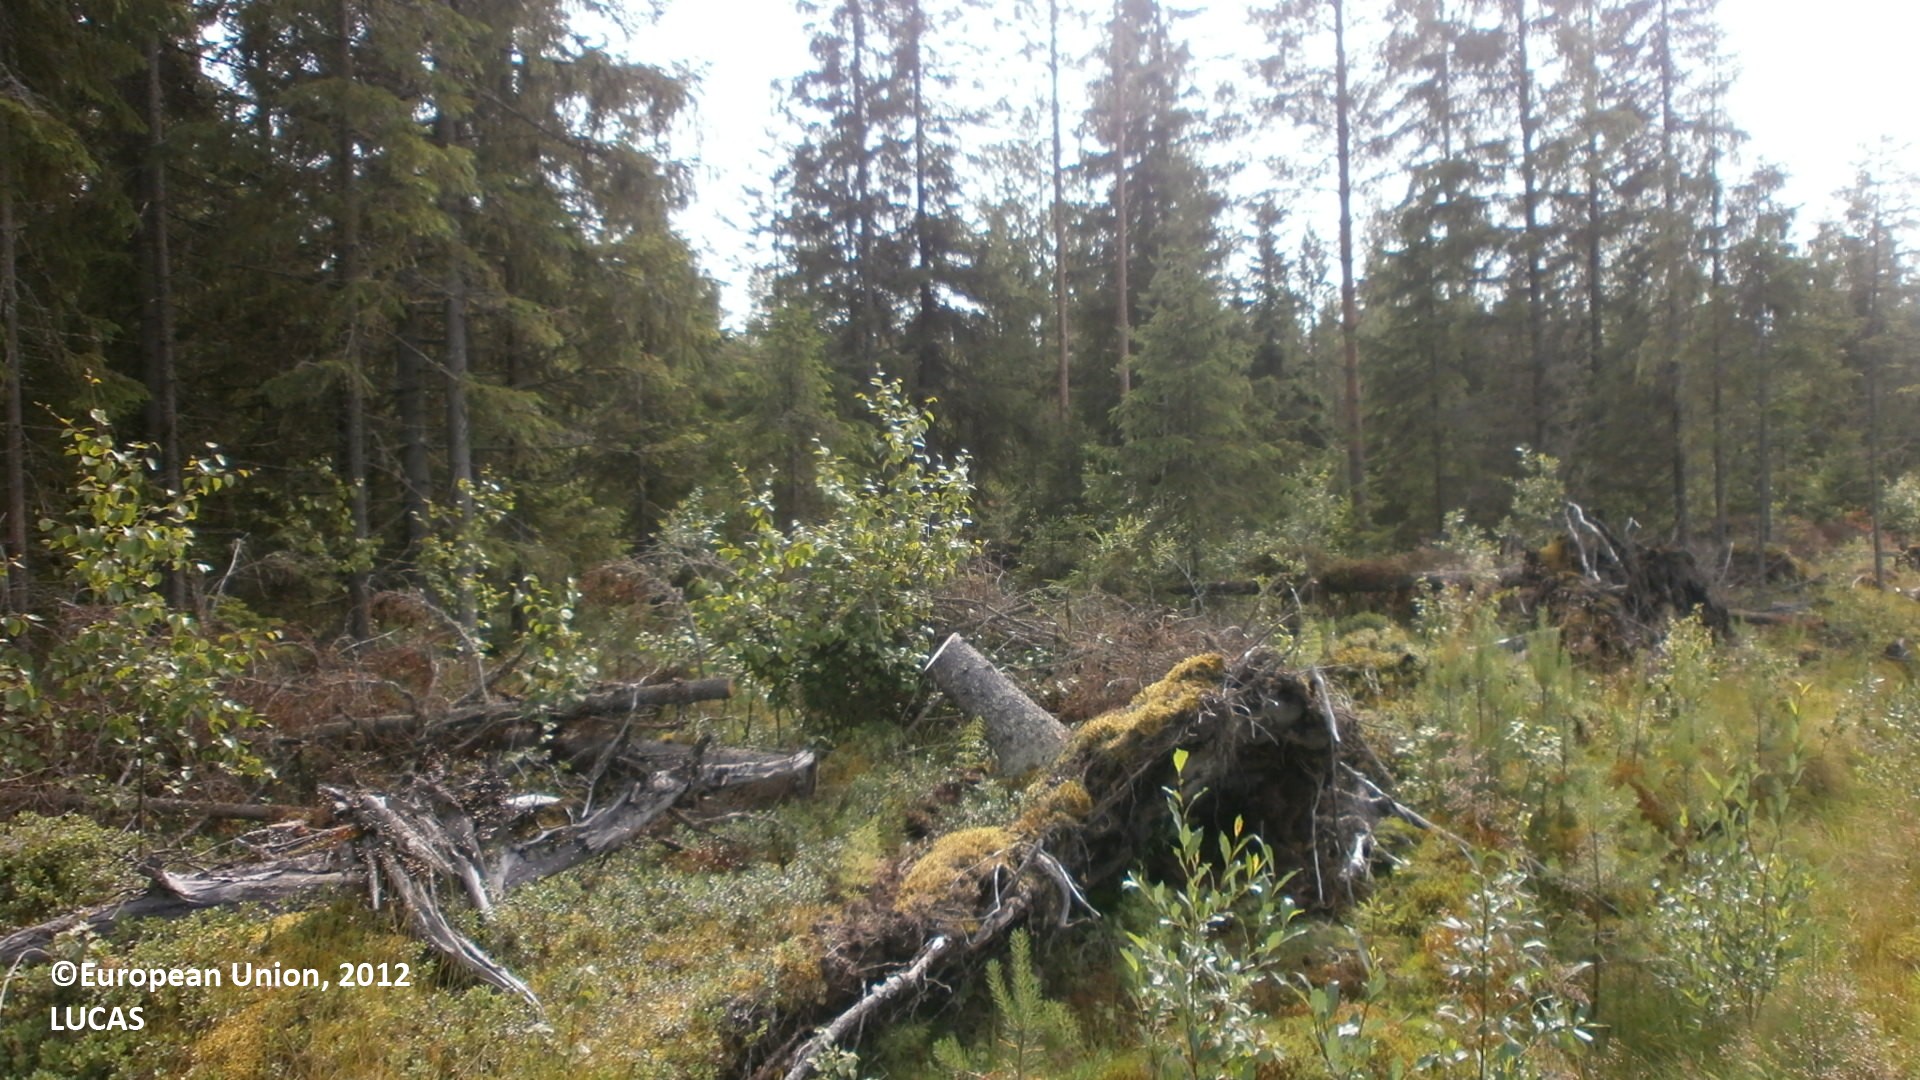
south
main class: Cropland
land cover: Barley
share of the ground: > 75 %
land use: Agriculture (excluding fallow land and kitchen gardens)
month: July
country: FI
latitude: 64.2249
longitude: 23.8915
